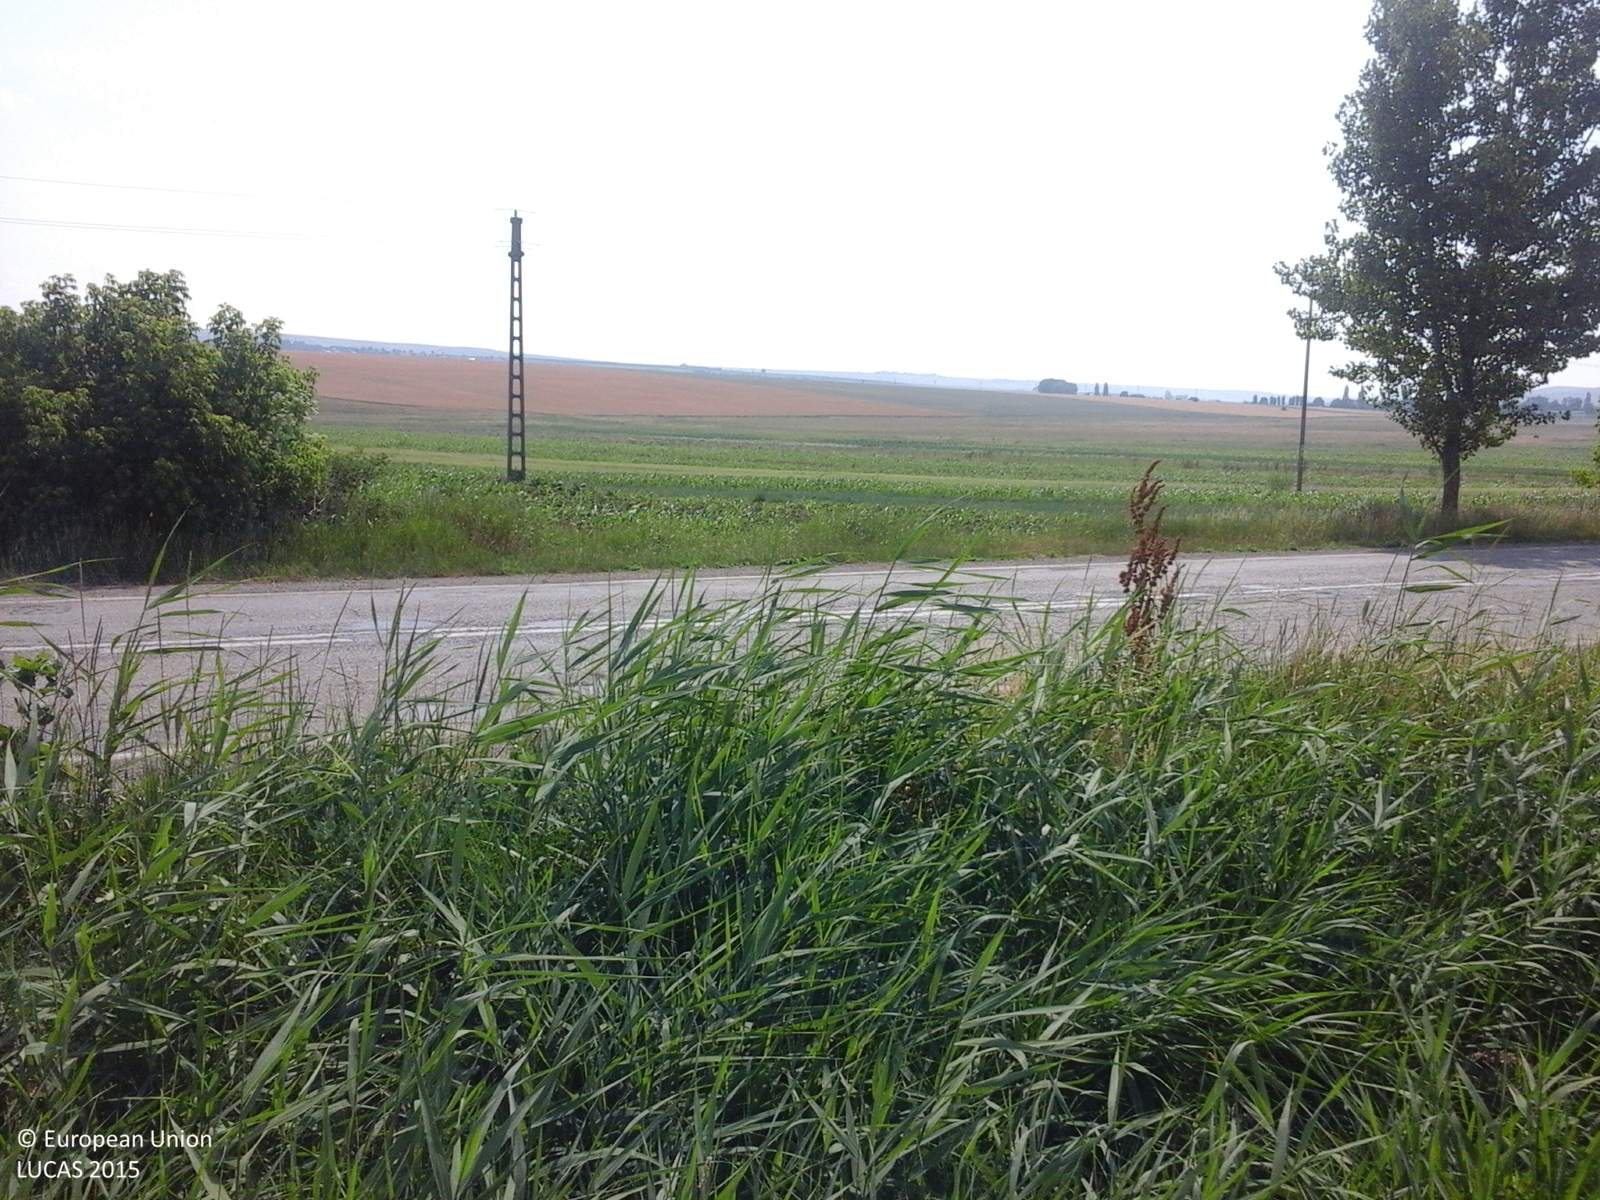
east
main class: Cropland
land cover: Maize
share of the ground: 10 - 25 %
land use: Agriculture (excluding fallow land and kitchen gardens)
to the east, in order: Maize; Grass margins; Ditches and canals; Paved roads, cycling and walking lanes; Grass margins; Maize; Electric lines; Maize; Lucerne; Maize; Barley; Maize; Spontaneously vegetated surfaces
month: June
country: RO
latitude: 47.3570
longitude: 26.9546
